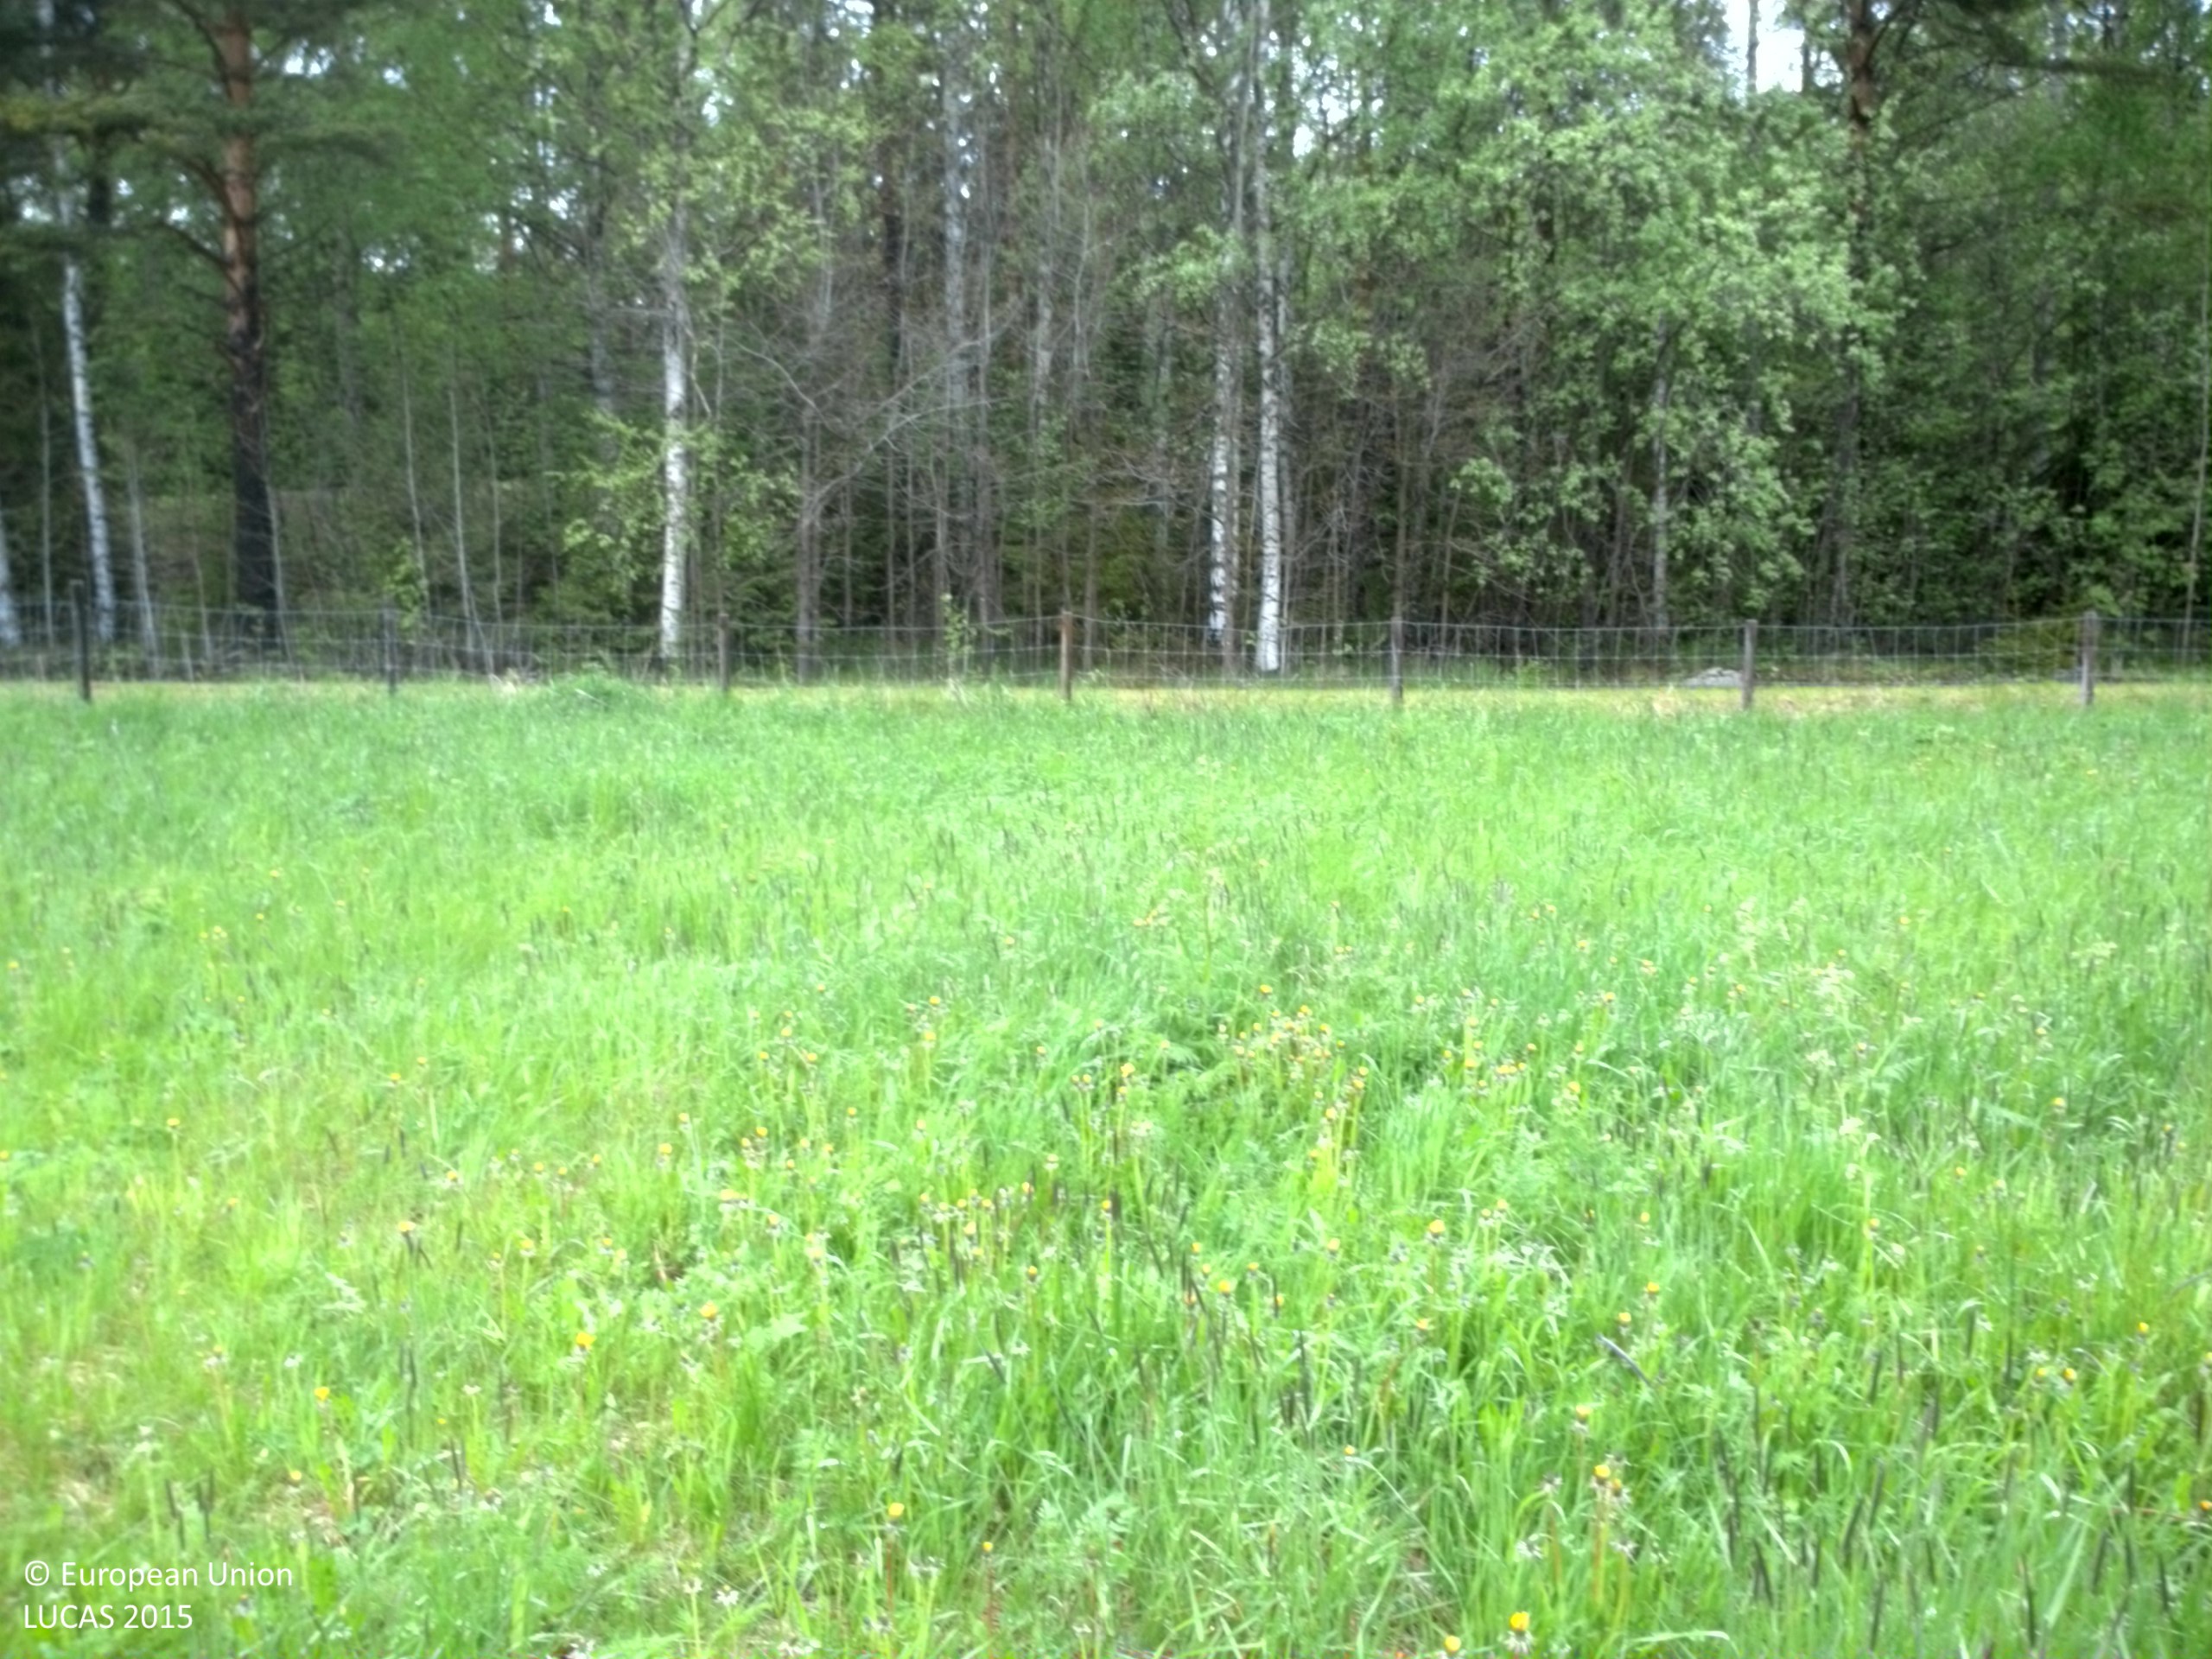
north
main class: Grassland
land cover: Spontaneously vegetated surfaces
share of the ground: > 75 %
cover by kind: herbaceous plants 100 %
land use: Agriculture (excluding fallow land and kitchen gardens)
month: June
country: SE
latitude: 63.1568
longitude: 16.9828
